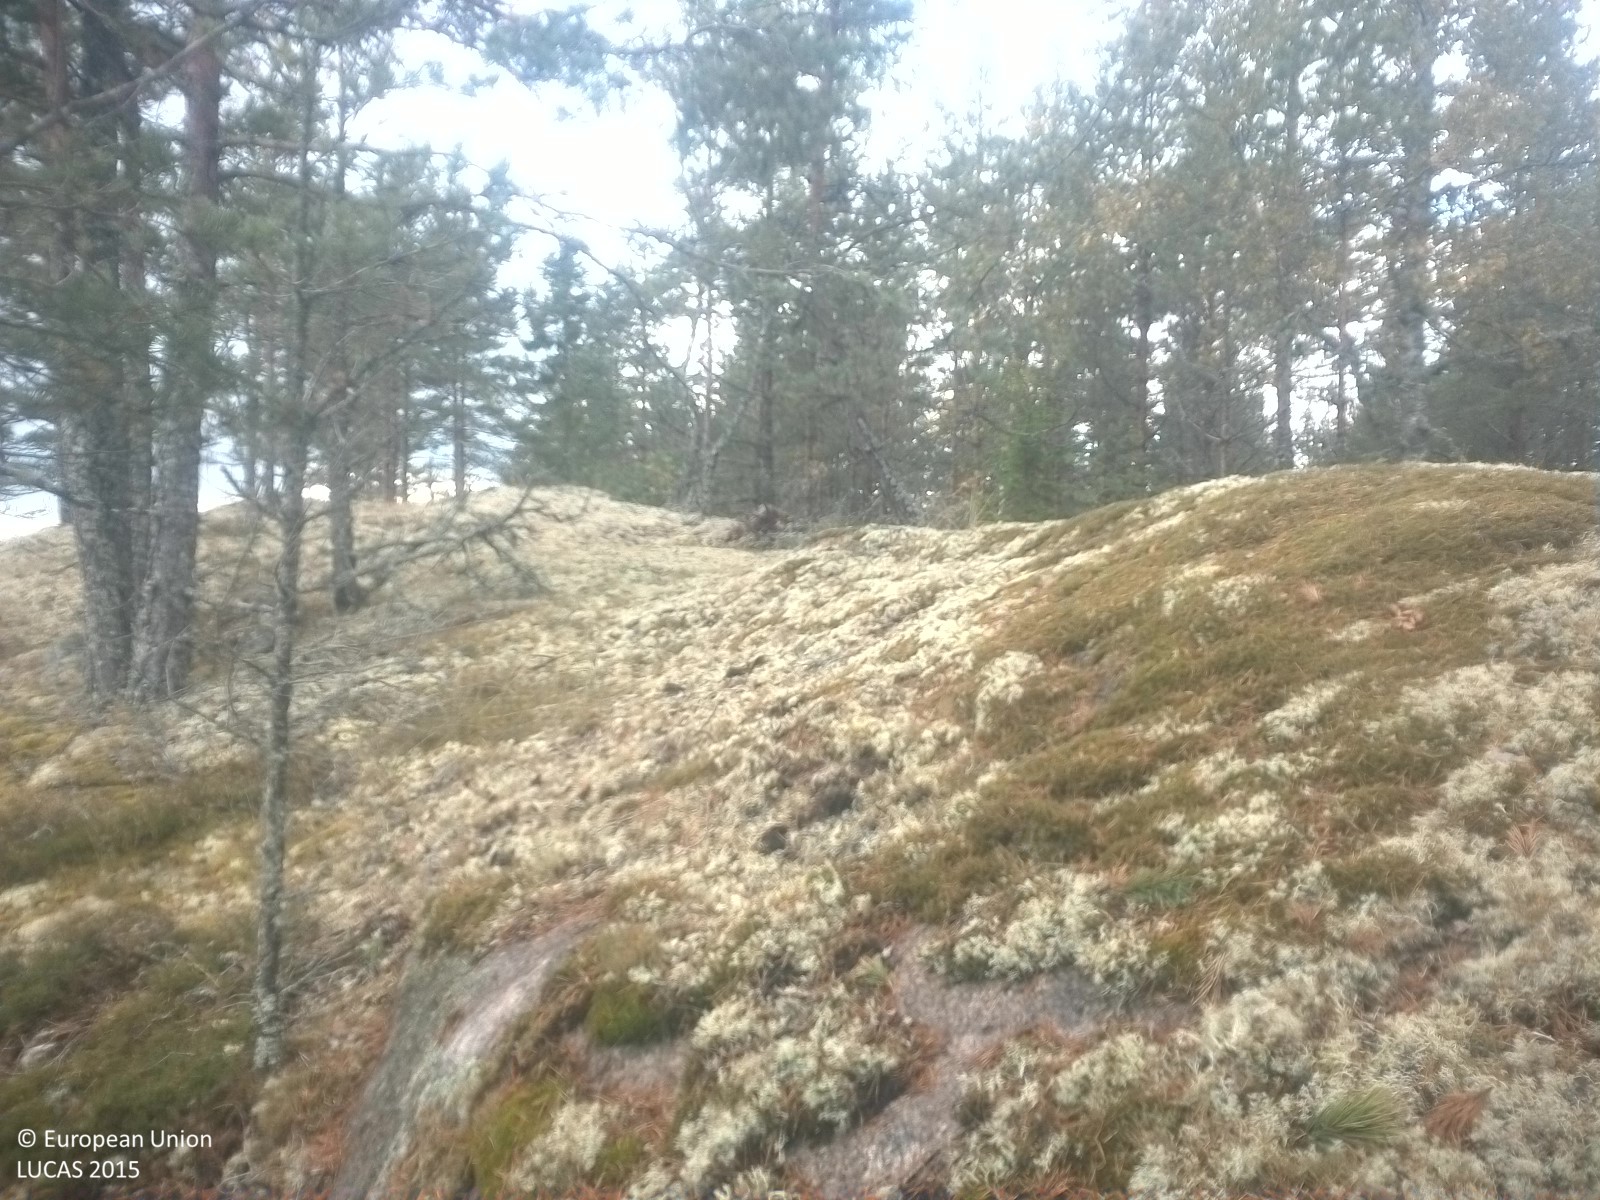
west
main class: Woodland
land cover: Pine dominated coniferous woodland
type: boreal forest
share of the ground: 10 - 25 %
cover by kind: lichens and mosses 60 %, coniferous forest trees 20 %, shrubs 15 %, herbaceous plants 5 %
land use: Forestry
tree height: < 5 m
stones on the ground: 10 - 25 %
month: September
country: SE
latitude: 58.7981
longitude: 16.2073
